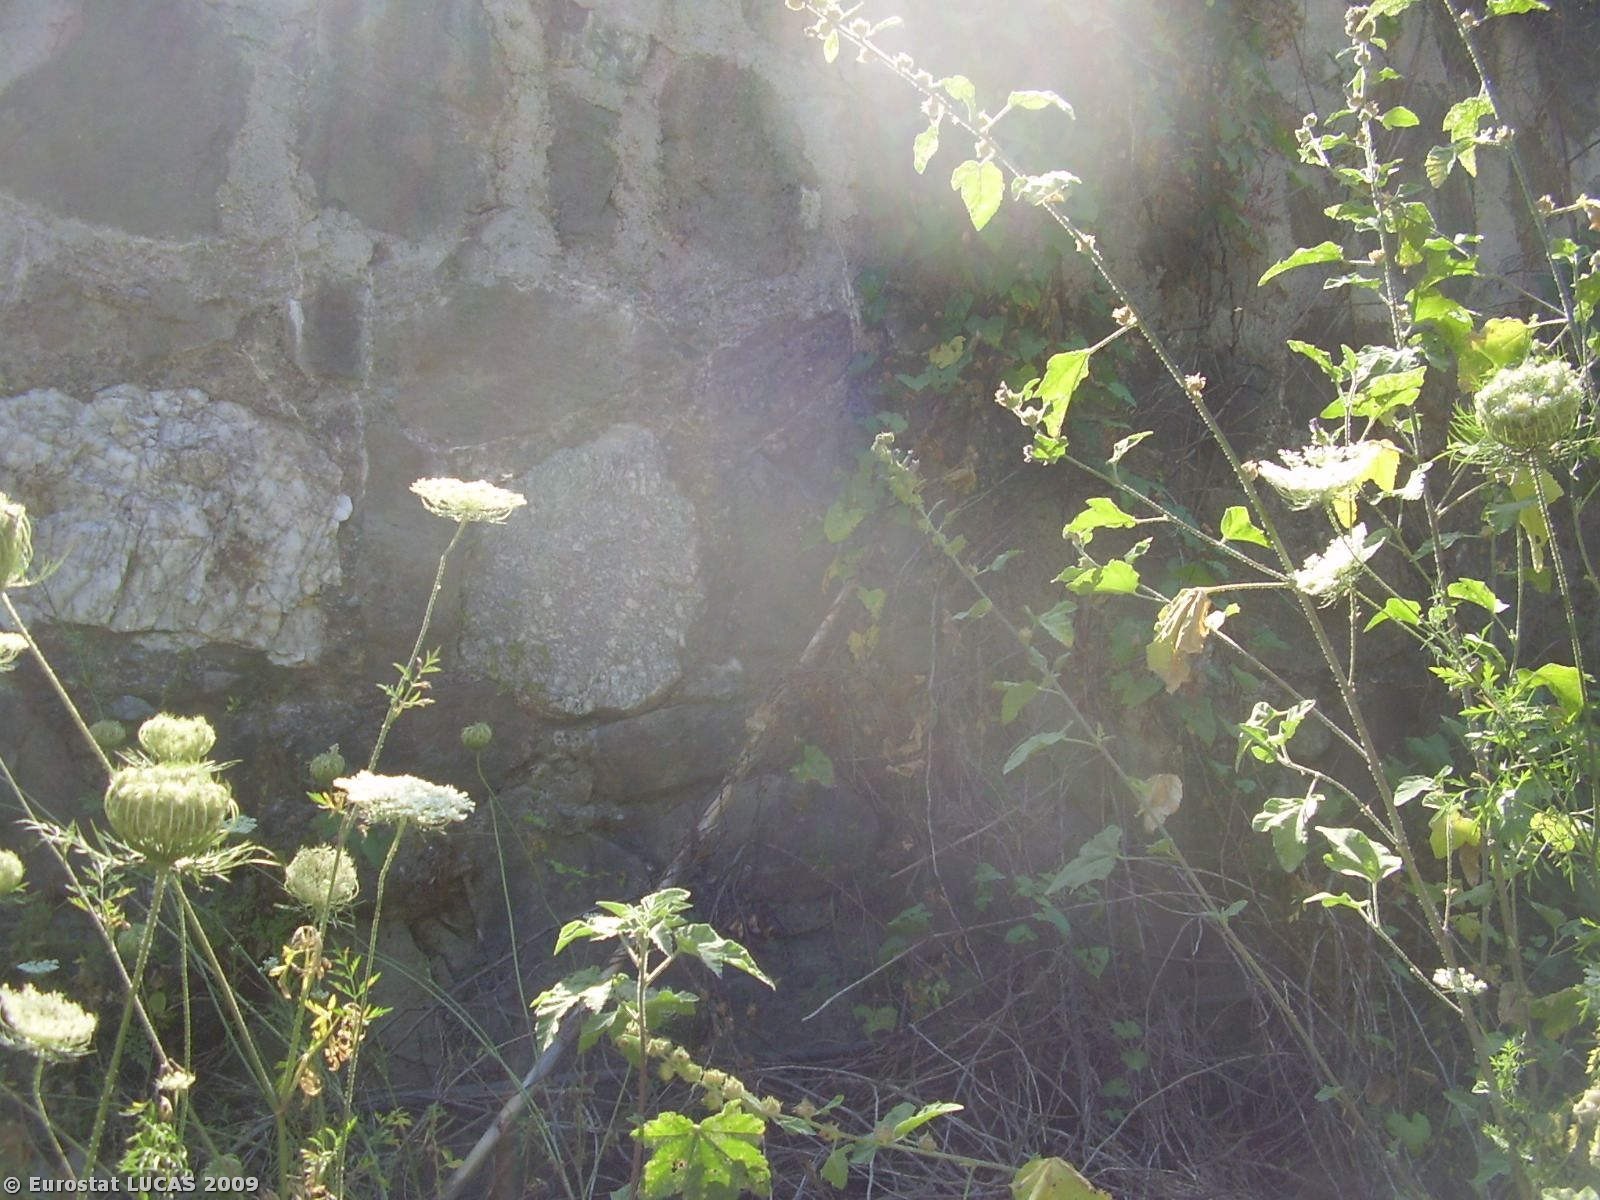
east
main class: Cropland
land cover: Vineyards
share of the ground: 50 - 75 %
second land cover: Bare land
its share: > 75 %
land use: Agriculture (excluding fallow land and kitchen gardens)
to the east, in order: Vineyards; Bare land; Tracks; Olive groves; Bare land; Tracks; Olive groves; Bare land; Tracks; Olive groves; Bare land; Tracks; Olive groves; Bare land
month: June
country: IT
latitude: 37.9257
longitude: 15.3230
